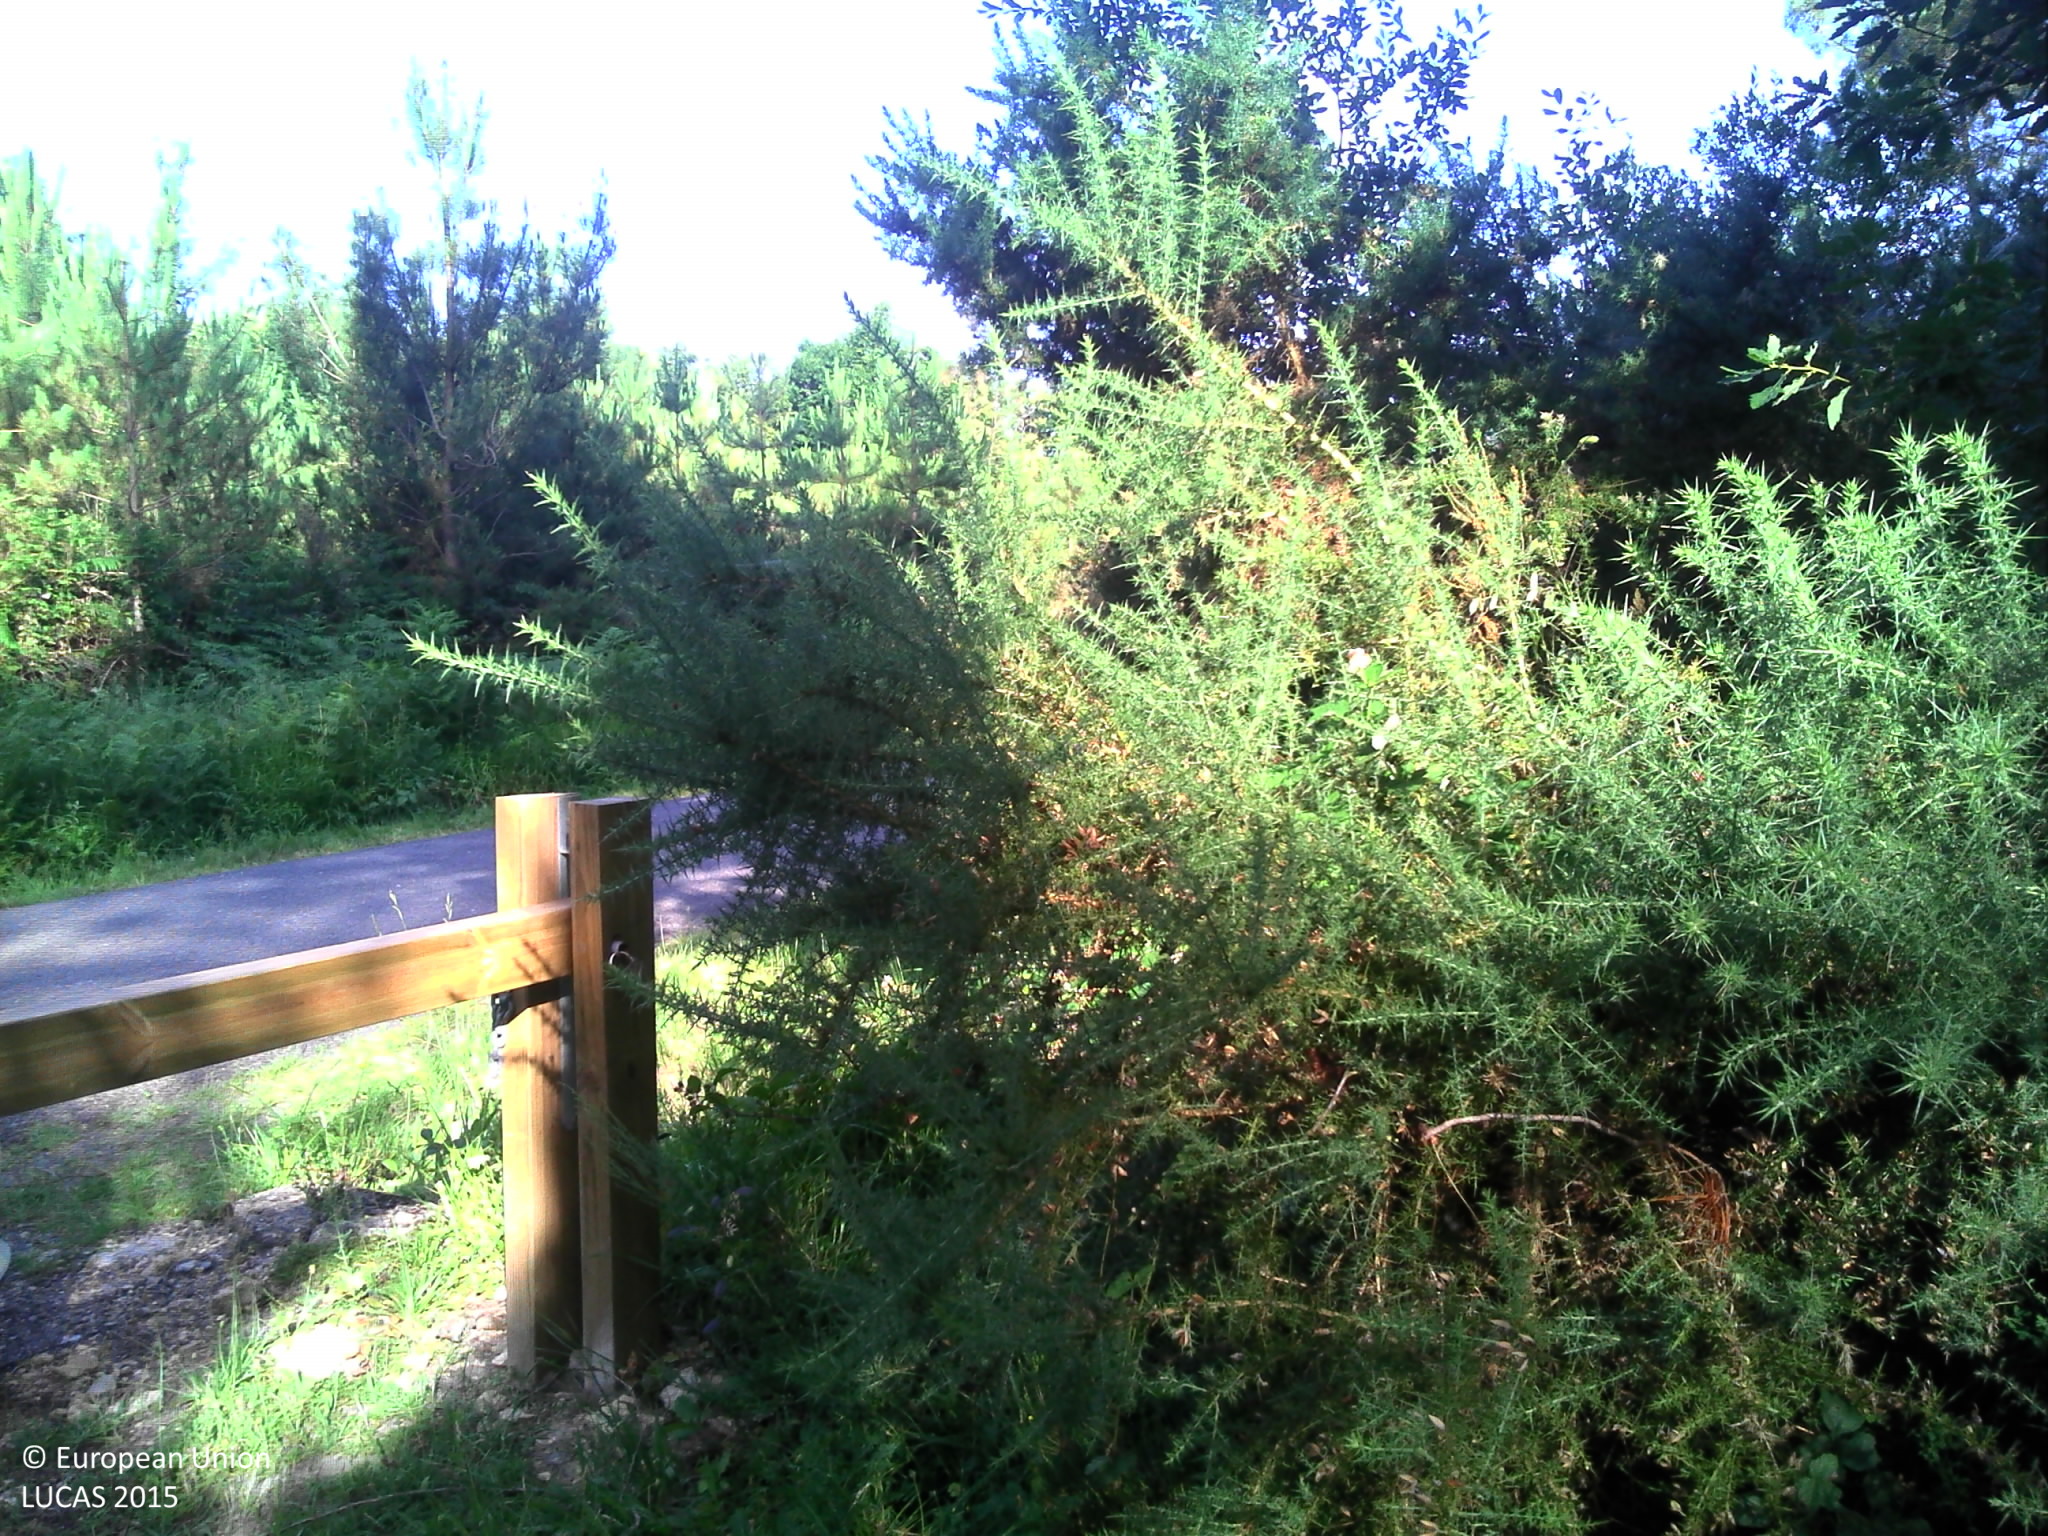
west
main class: Woodland
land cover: Pine dominated mixed woodland
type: hemiboreal forest and nemoral coniferous forest and mixed broadleaved-coniferous forest
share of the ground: > 75 %
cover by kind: broadleaved forest trees 55 %, coniferous forest trees 25 %, shrubs 10 %, herbaceous plants 10 %
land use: Forestry
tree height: > 5 m
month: June
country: FR
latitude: 46.5231
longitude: 0.2689
